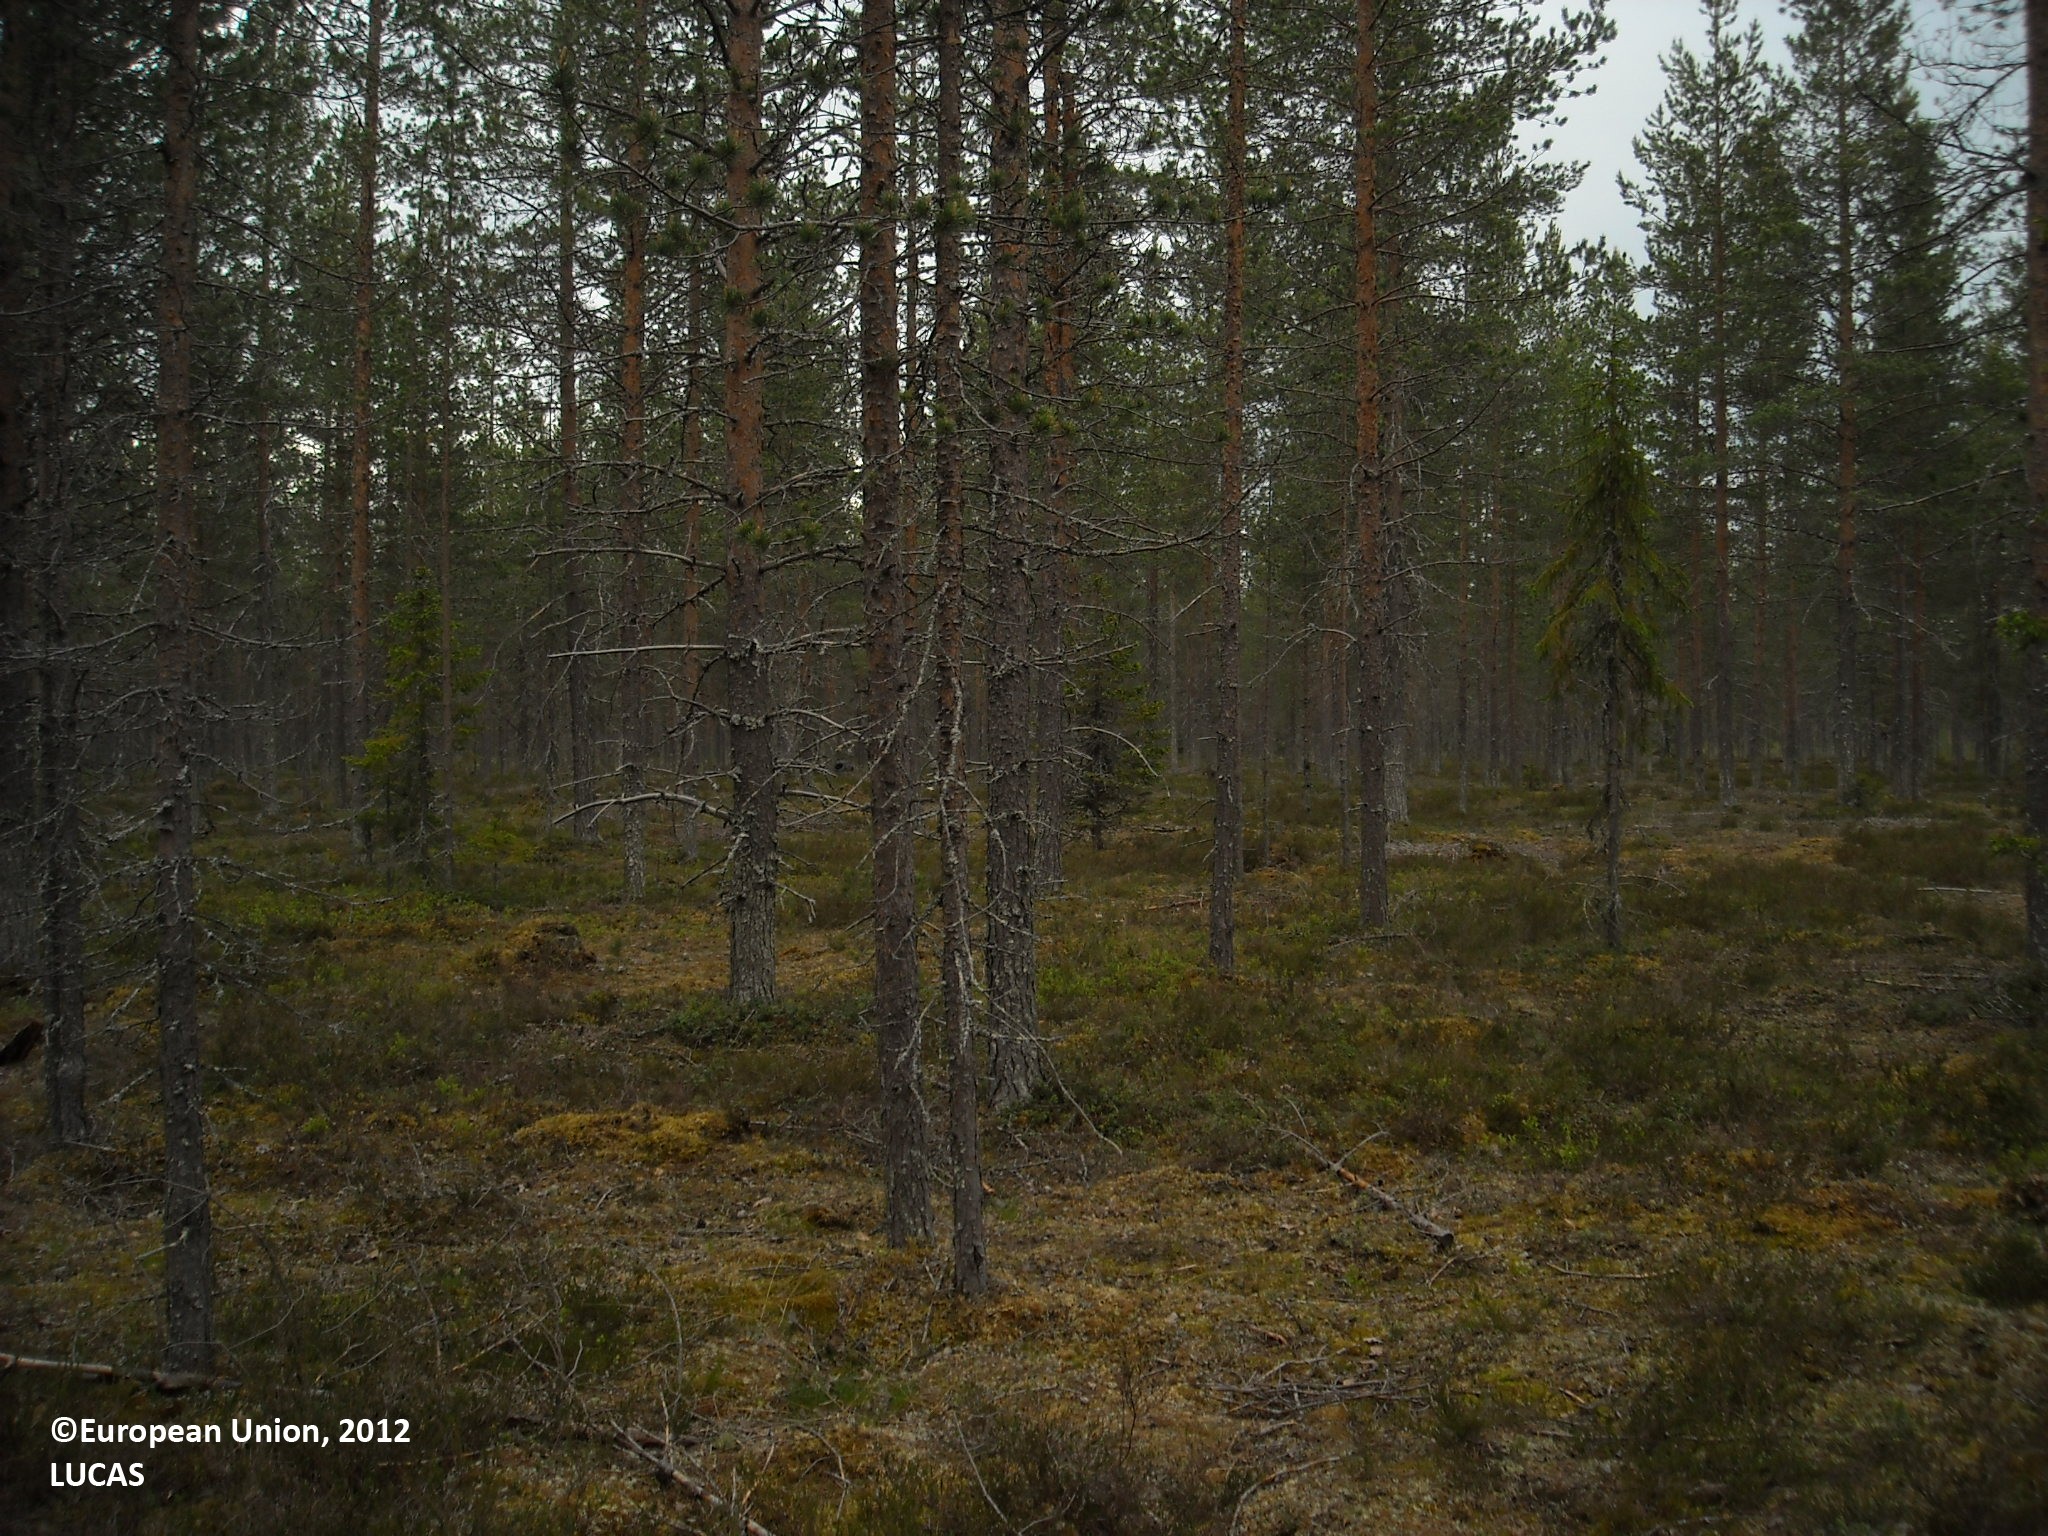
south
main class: Woodland
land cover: Pine dominated coniferous woodland
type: boreal forest
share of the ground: 50 - 75 %
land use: Forestry
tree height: > 5 m
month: June
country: FI
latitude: 65.5469
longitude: 27.9162
